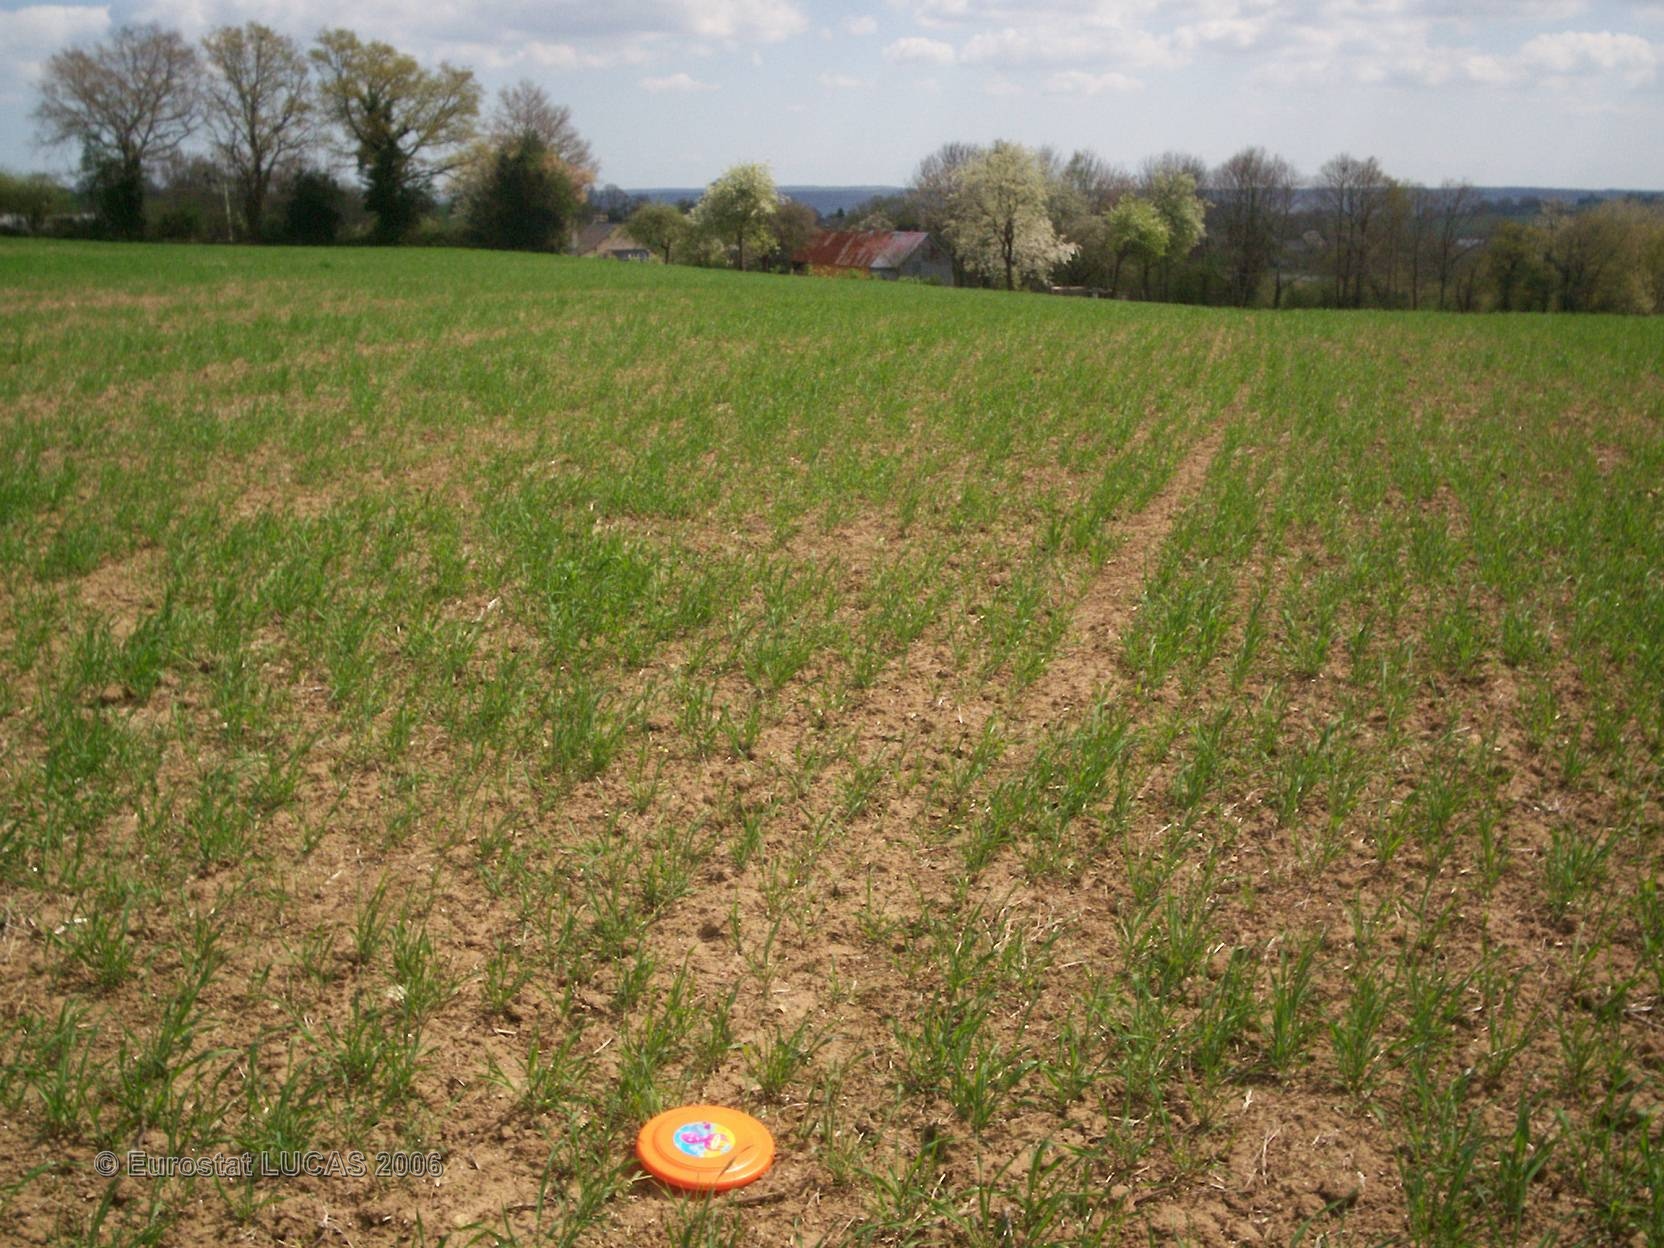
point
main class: Cropland
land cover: Rye
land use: Agriculture (excluding fallow land and kitchen gardens)
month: April
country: FR
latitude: 48.2342
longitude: -0.2501
